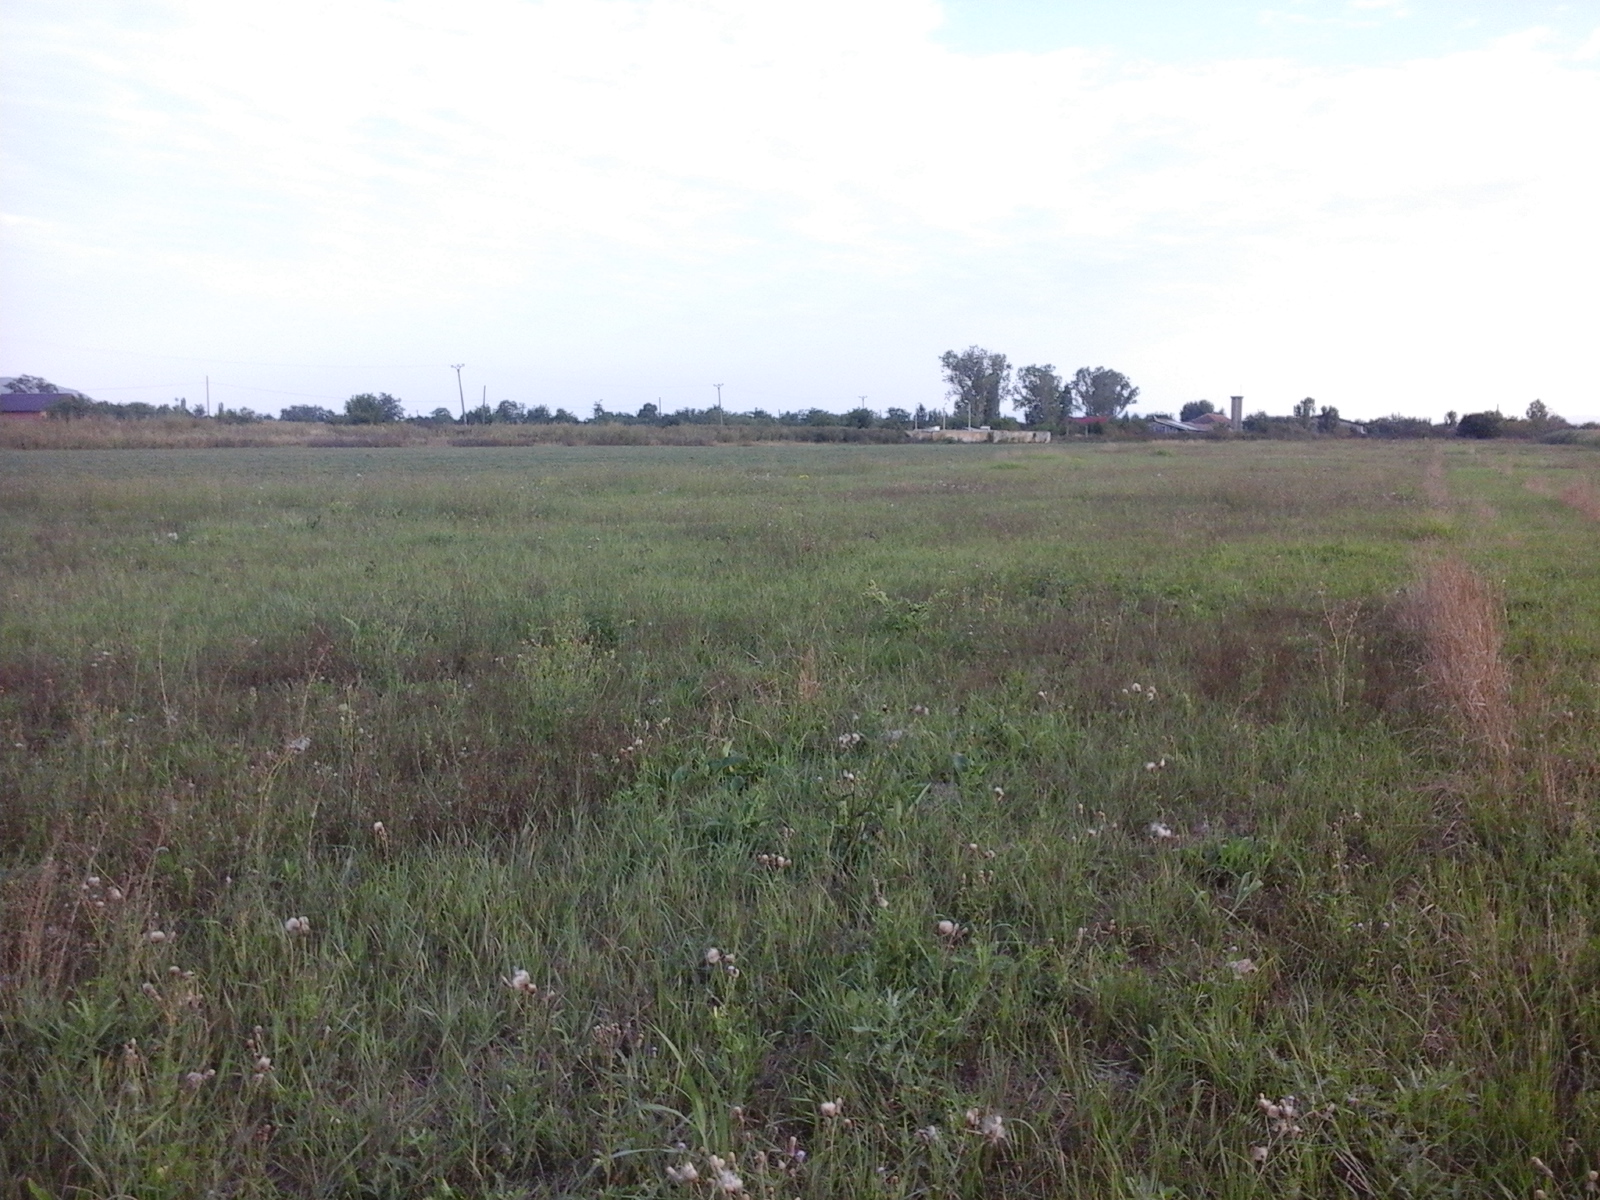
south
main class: Grassland
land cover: Spontaneously vegetated surfaces
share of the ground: > 75 %
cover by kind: herbaceous plants 100 %
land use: Agriculture (excluding fallow land and kitchen gardens)
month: August
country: RO
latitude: 46.4449
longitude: 21.7693
